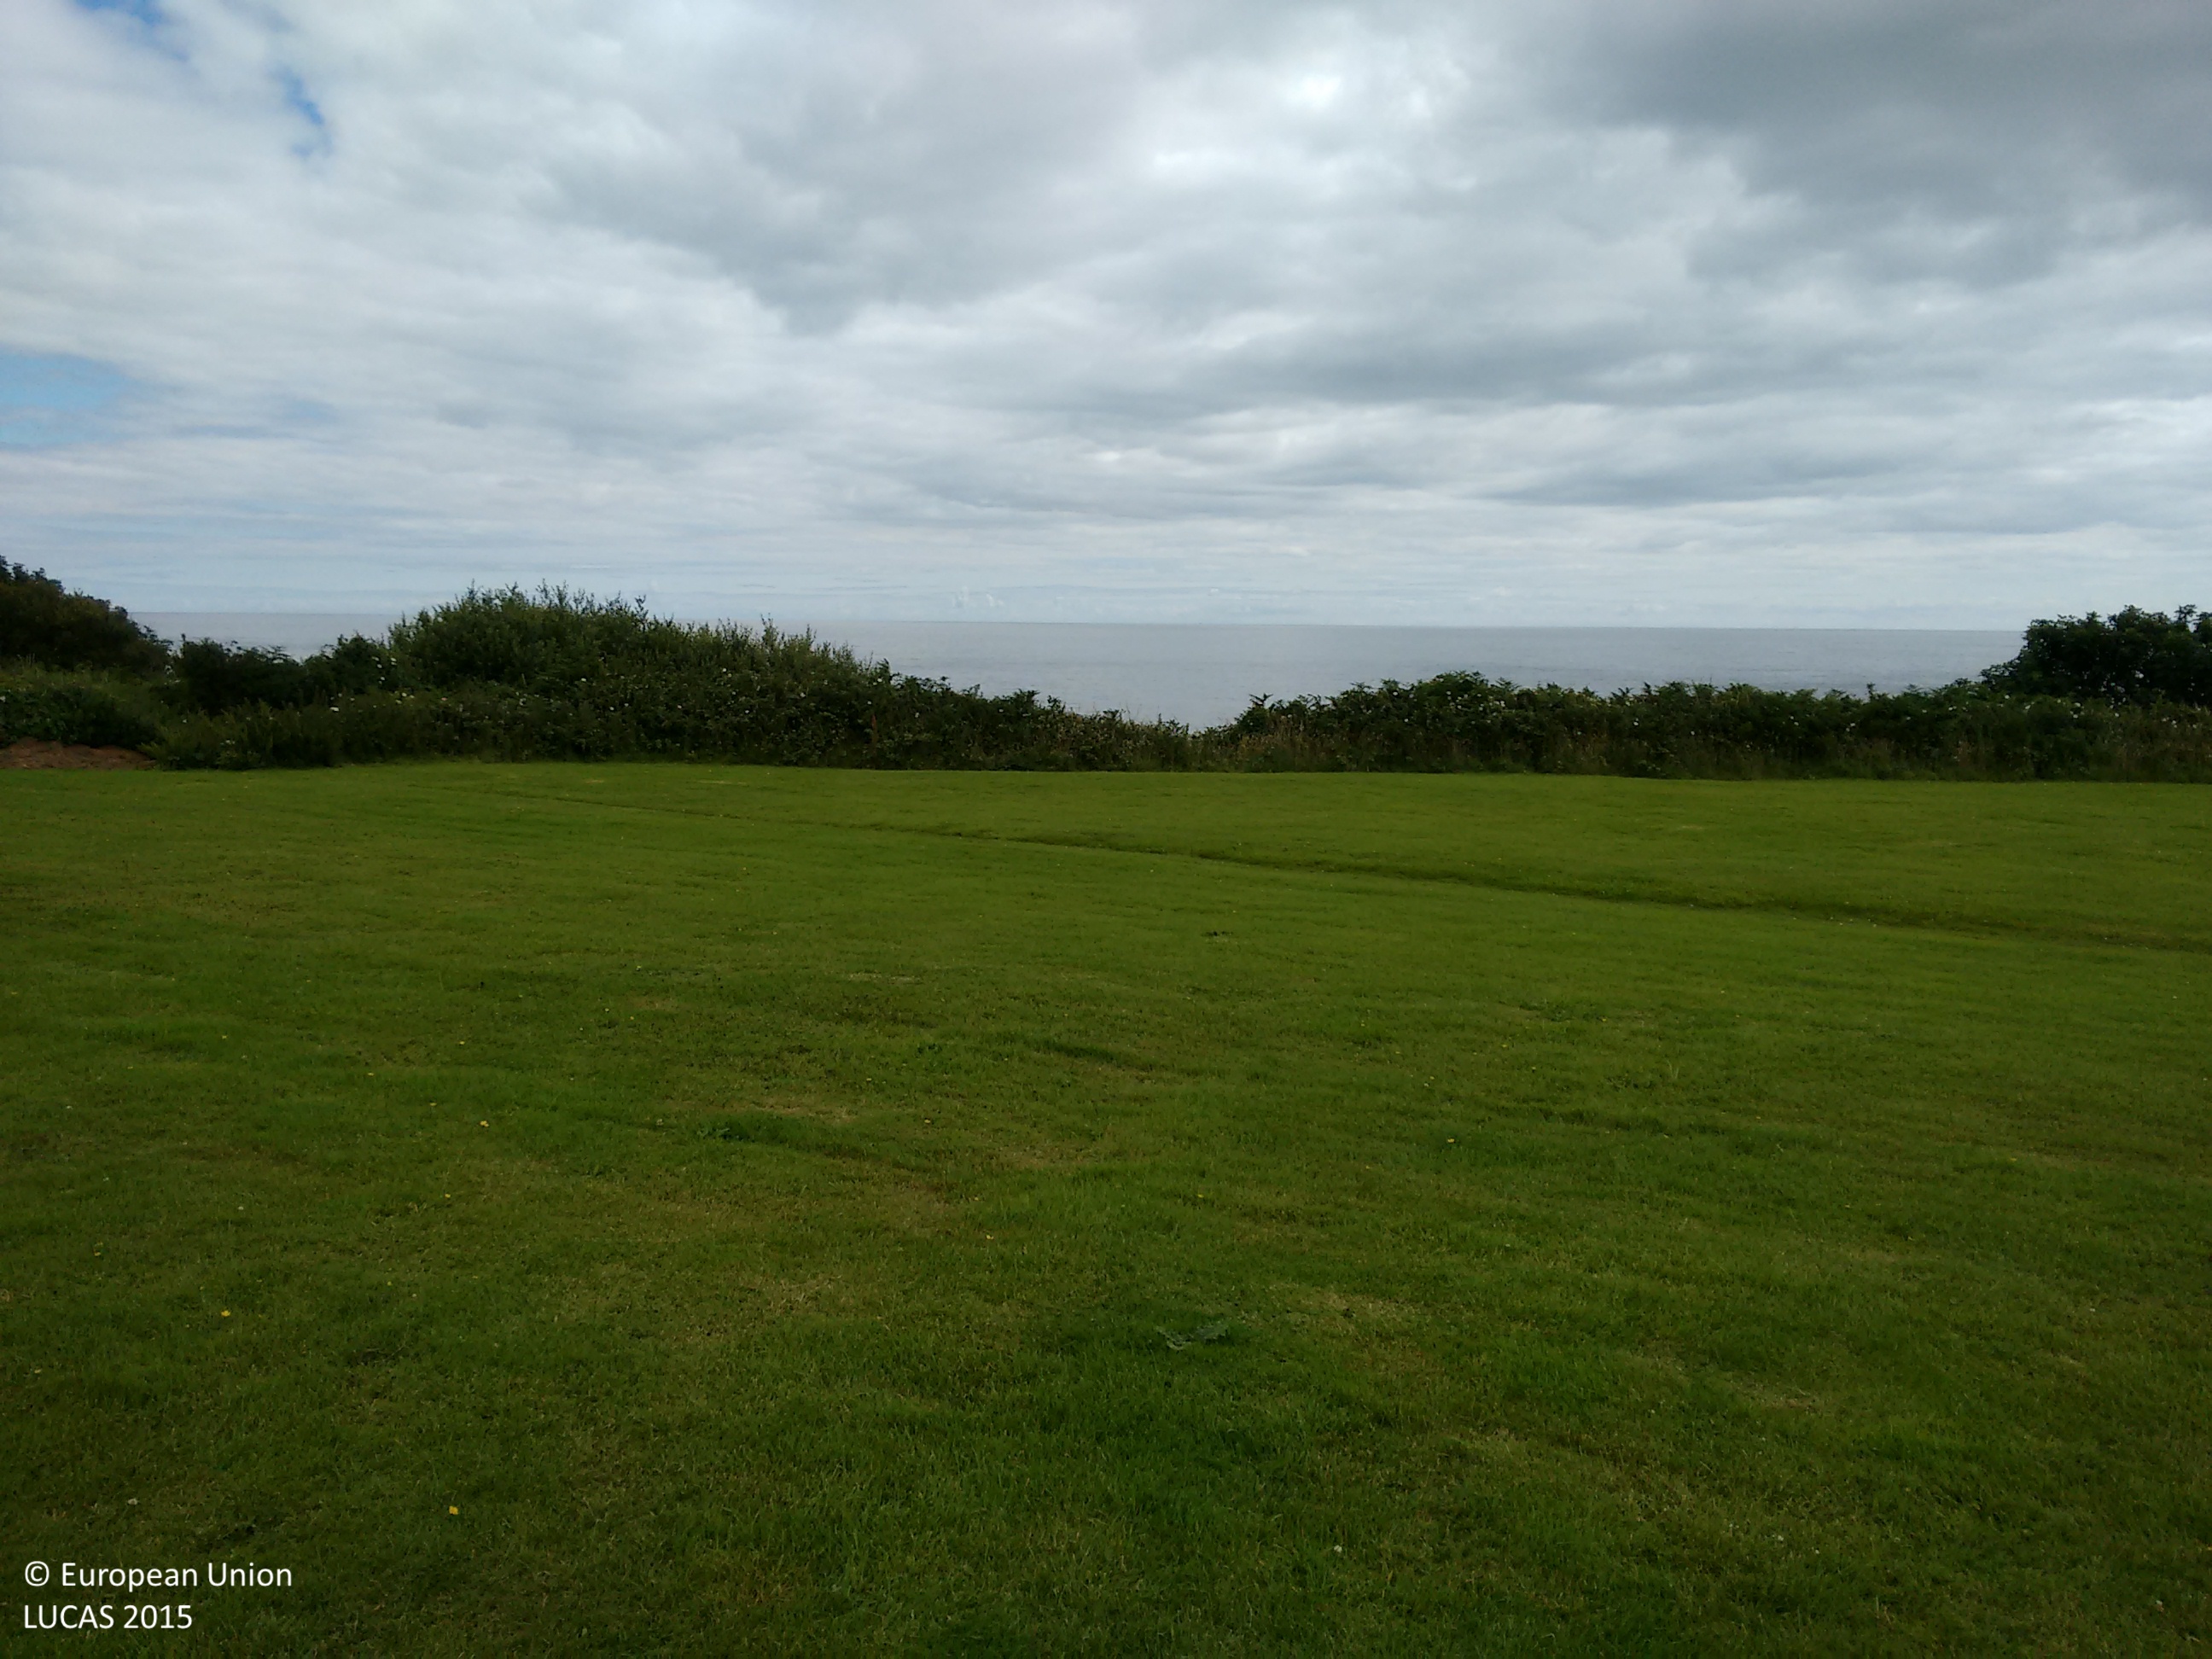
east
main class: Grassland
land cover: Grassland without tree/shrub cover
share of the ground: > 75 %
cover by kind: herbaceous plants 100 %
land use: Amenities, museums, leisure
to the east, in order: Grassland without tree/shrub cover; Shrubland without tree cover; Rocks and stones; Sand; Transitional water bodies
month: July
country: IE
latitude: 52.9099
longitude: -6.0396
